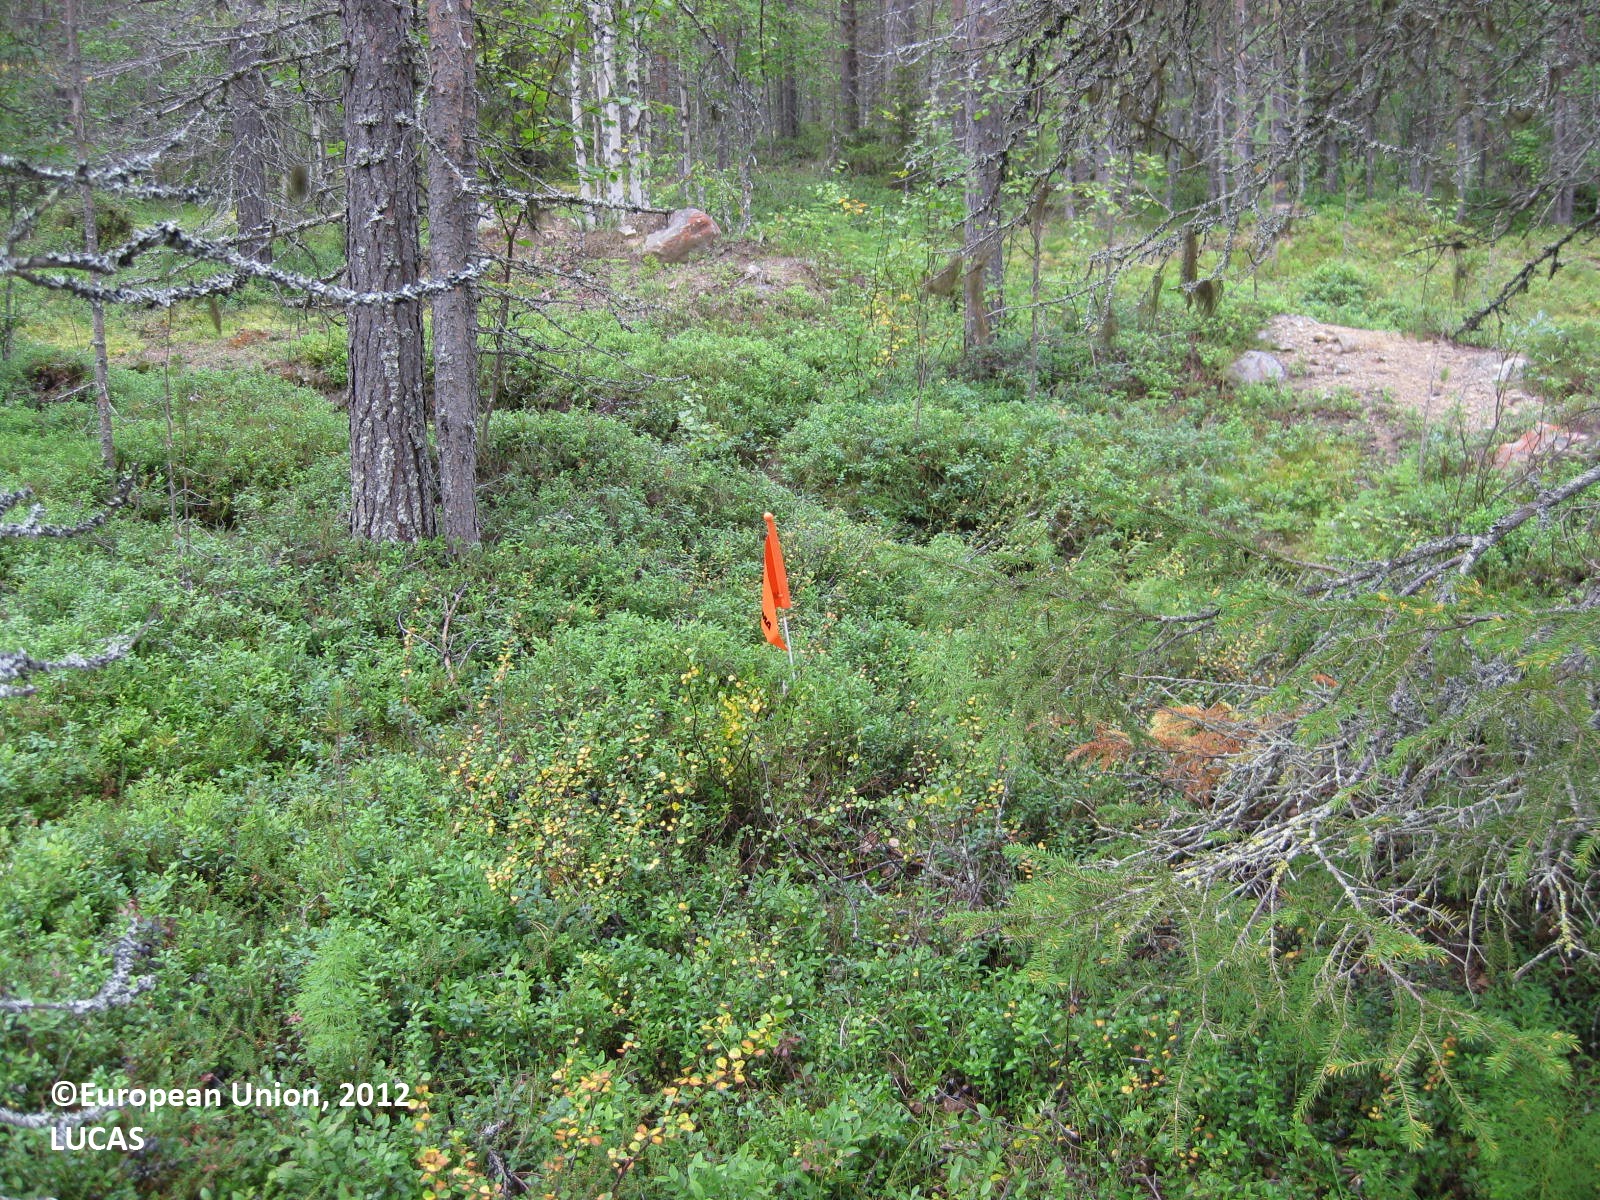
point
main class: Woodland
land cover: Pine dominated coniferous woodland
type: boreal forest
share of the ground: 50 - 75 %
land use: Forestry
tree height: > 5 m
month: August
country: FI
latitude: 66.4741
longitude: 28.9998
